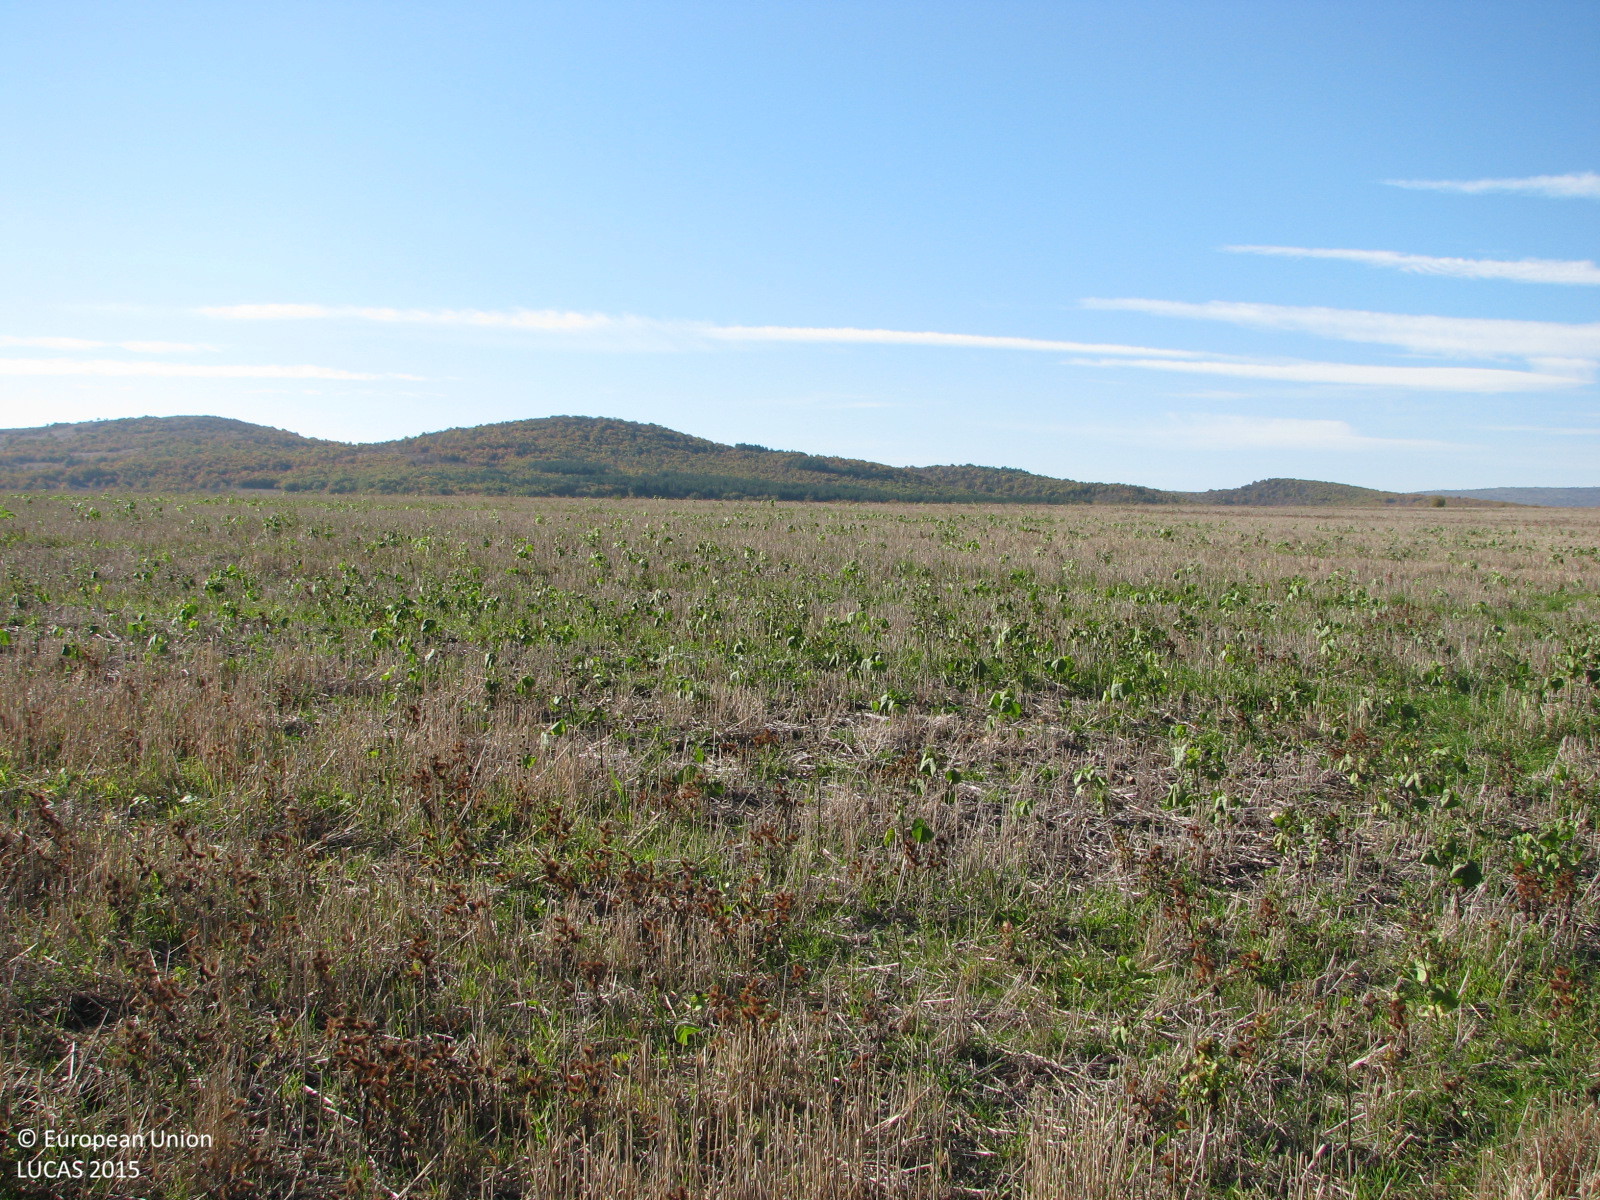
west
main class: Cropland
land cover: Common wheat
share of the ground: 25 - 50 %
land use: Agriculture (excluding fallow land and kitchen gardens)
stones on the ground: < 10 %
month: November
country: BG
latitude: 41.8675
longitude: 26.4559
